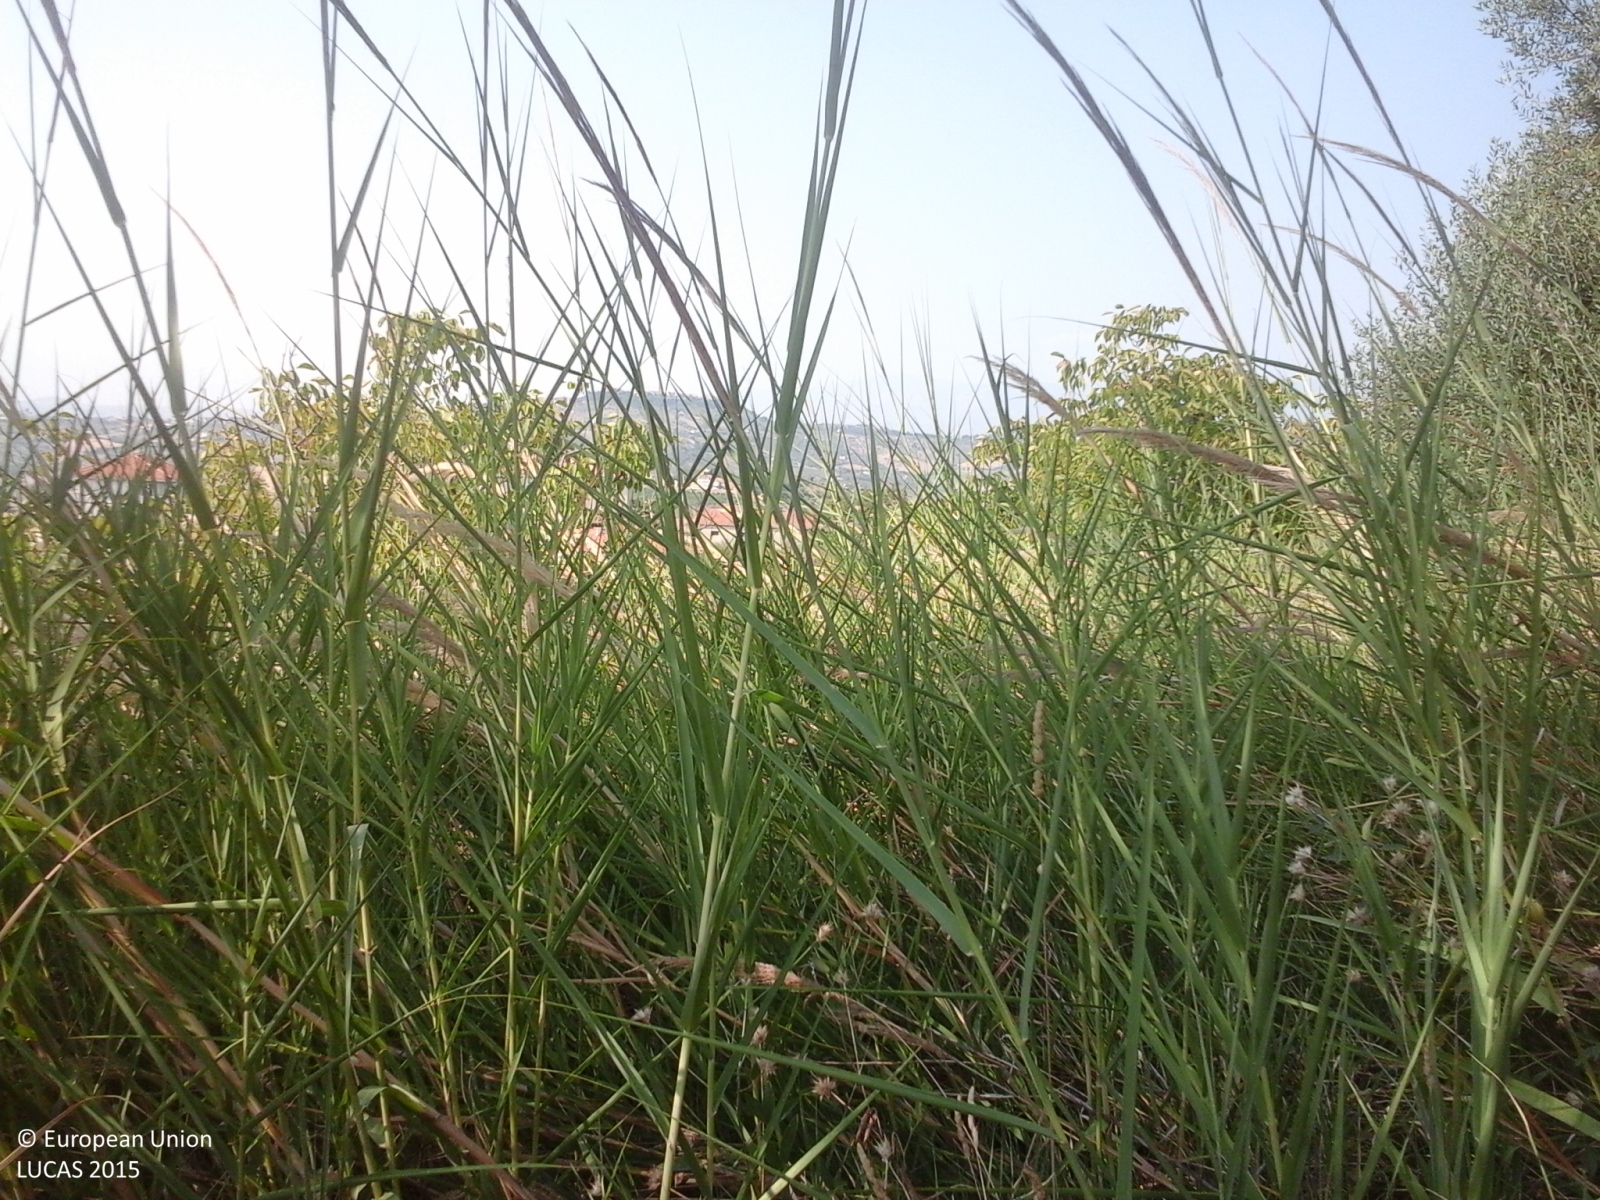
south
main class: Grassland
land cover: Grassland without tree/shrub cover
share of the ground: > 75 %
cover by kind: herbaceous plants 90 %, consolidated bare surface 5 %, unconsolidated bare surface 5 %
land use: Semi-natural and natural areas not in use
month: August
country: IT
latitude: 42.5533
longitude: 14.0924
